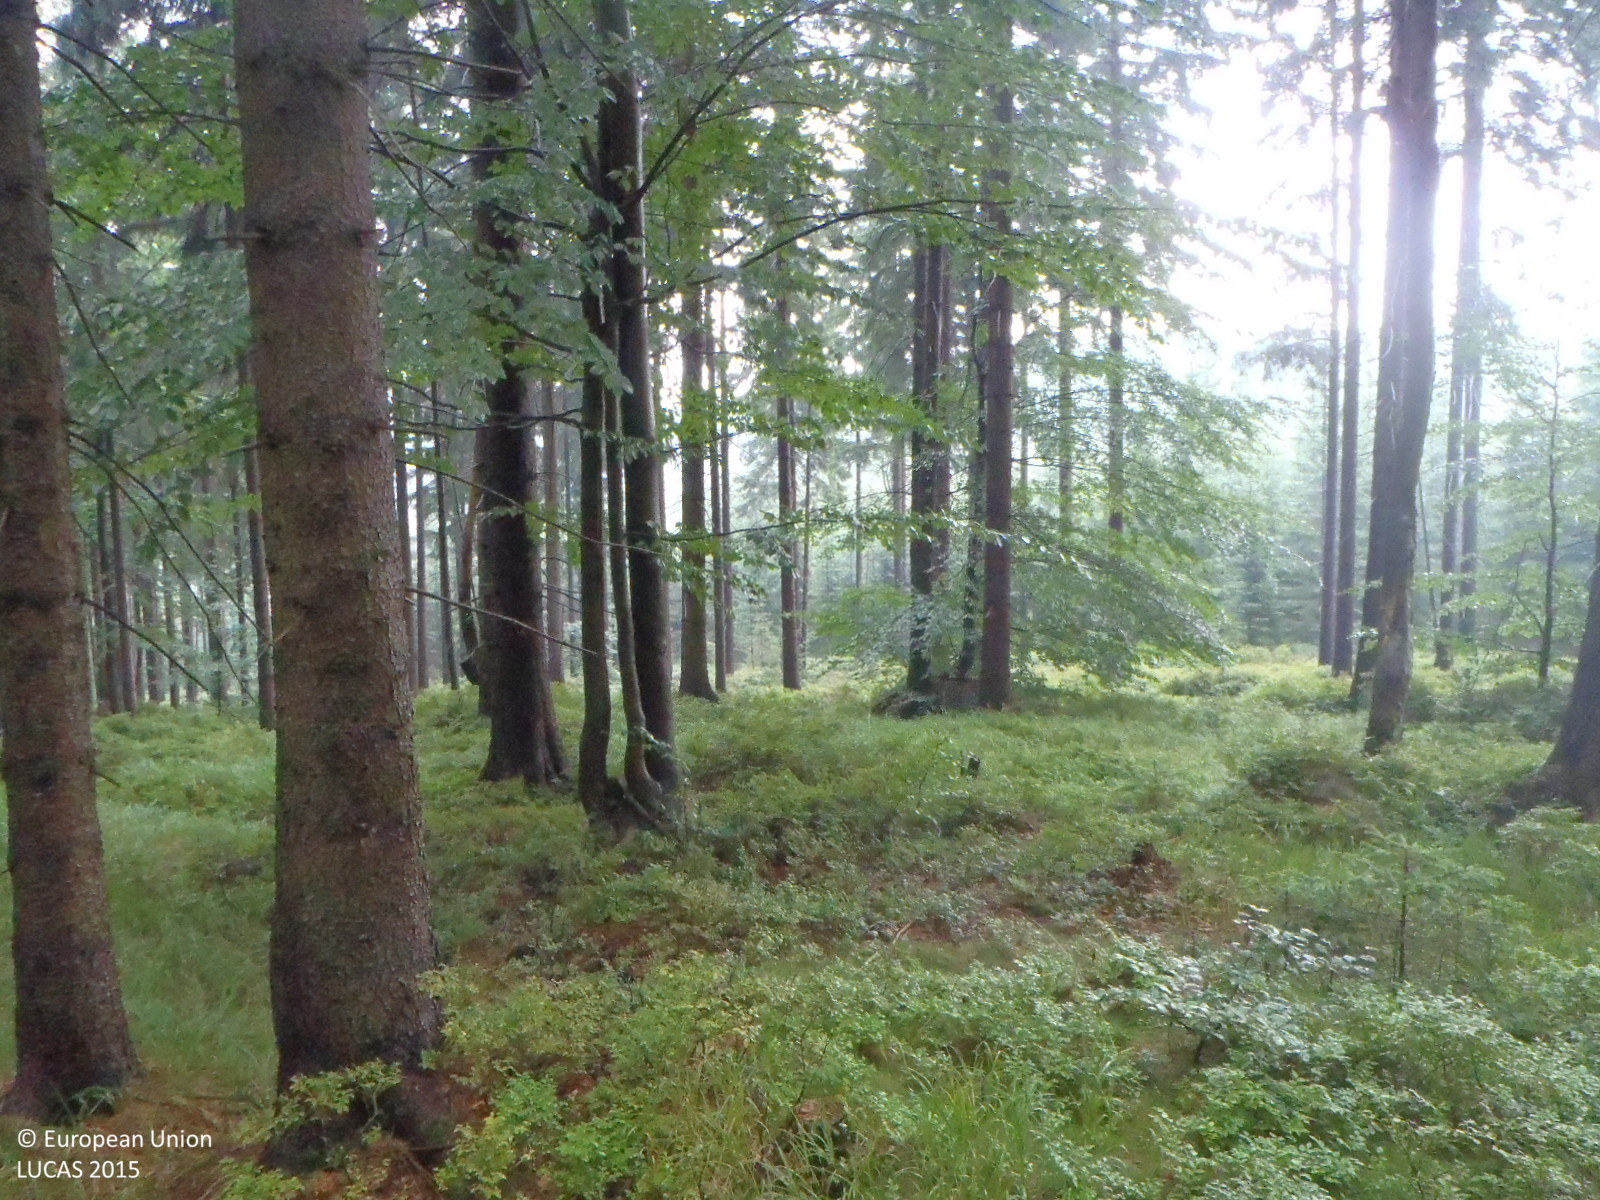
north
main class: Woodland
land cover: Spruce dominated coniferous woodland
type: hemiboreal forest and nemoral coniferous forest and mixed broadleaved-coniferous forest
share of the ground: > 75 %
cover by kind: coniferous forest trees 90 %, broadleaved forest trees 5 %, shrubs 5 %
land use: Forestry
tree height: > 5 m
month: August
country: CZ
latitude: 50.7834
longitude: 15.2657
